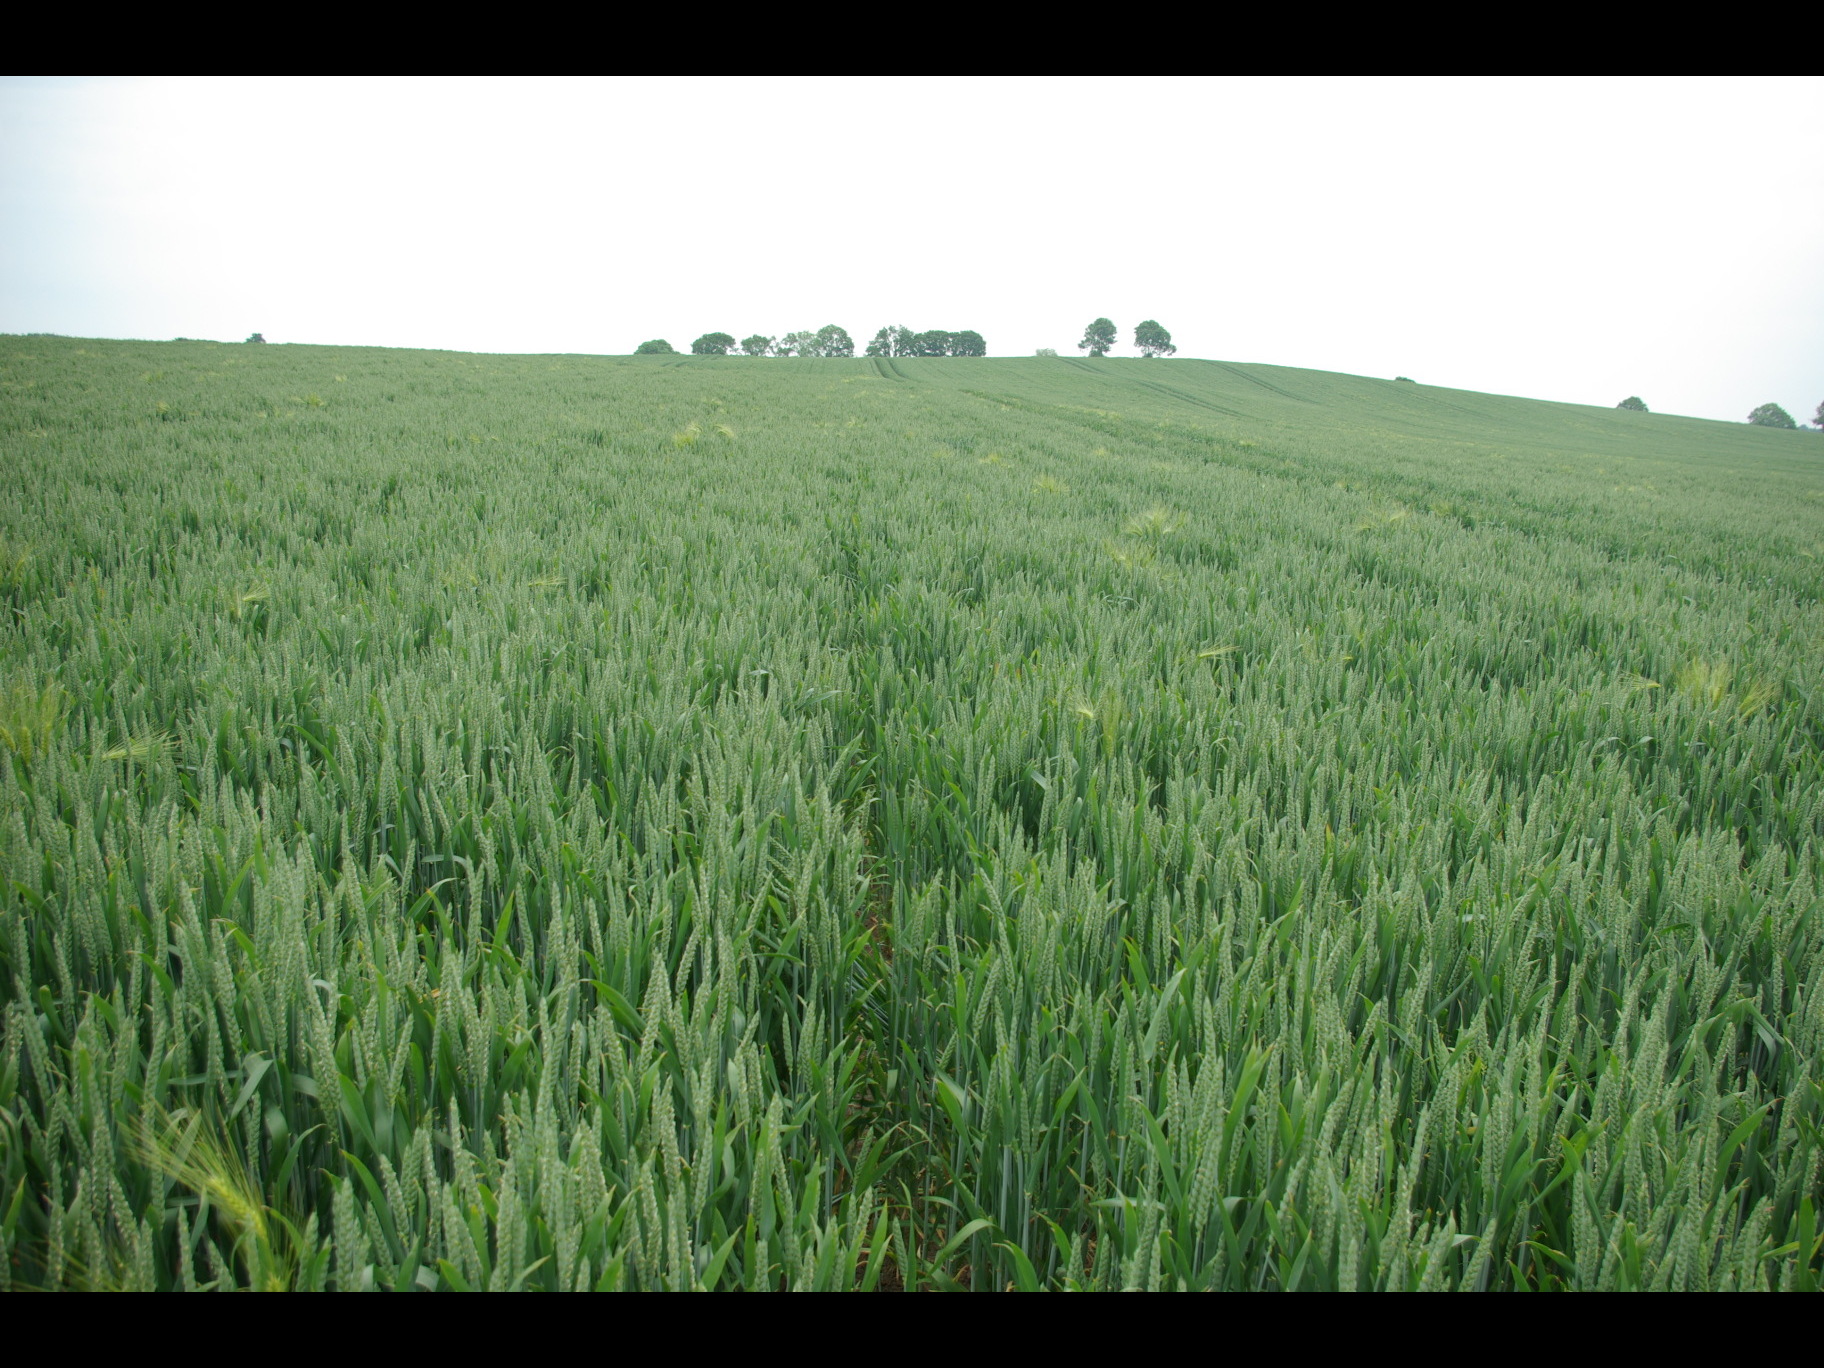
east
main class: Cropland
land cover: Common wheat
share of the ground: > 75 %
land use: Agriculture (excluding fallow land and kitchen gardens)
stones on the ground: 10 - 25 %
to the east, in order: Common wheat
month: June
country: DE
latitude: 54.4443
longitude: 9.9538
